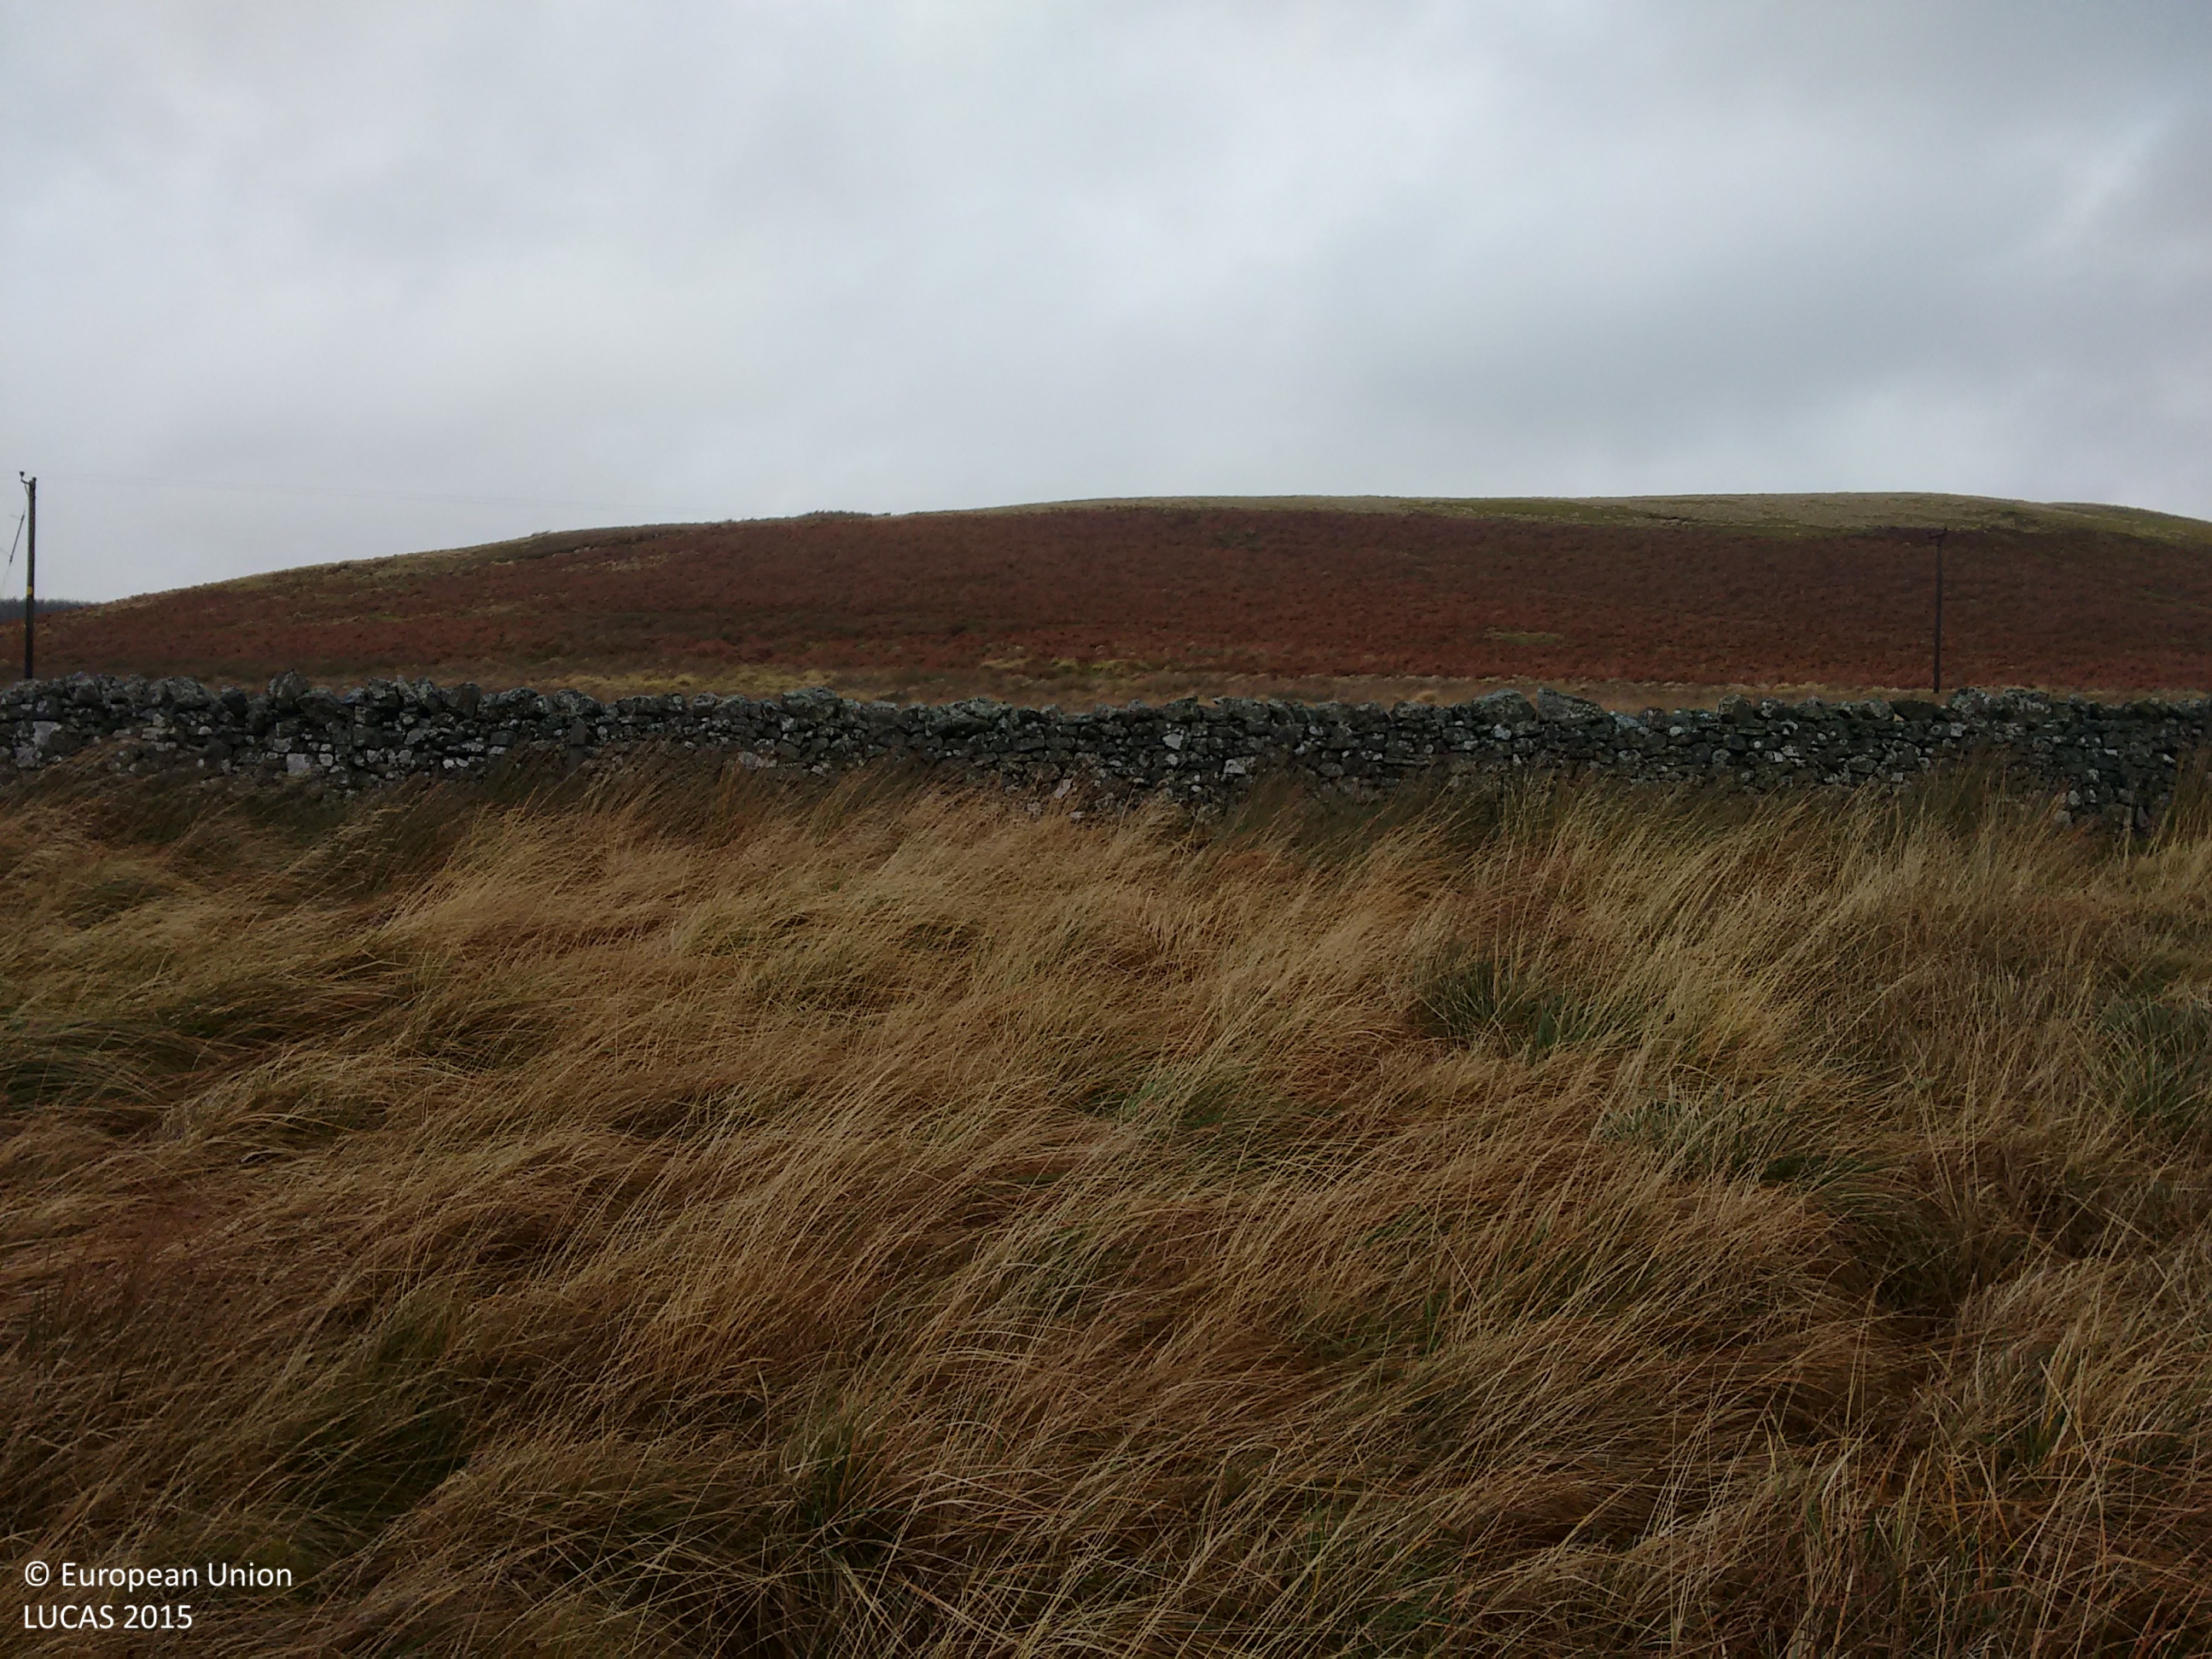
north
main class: Grassland
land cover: Grassland without tree/shrub cover
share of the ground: > 75 %
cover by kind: herbaceous plants 100 %
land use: Agriculture (excluding fallow land and kitchen gardens)
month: December
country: GB
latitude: 55.4197
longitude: -2.3982
